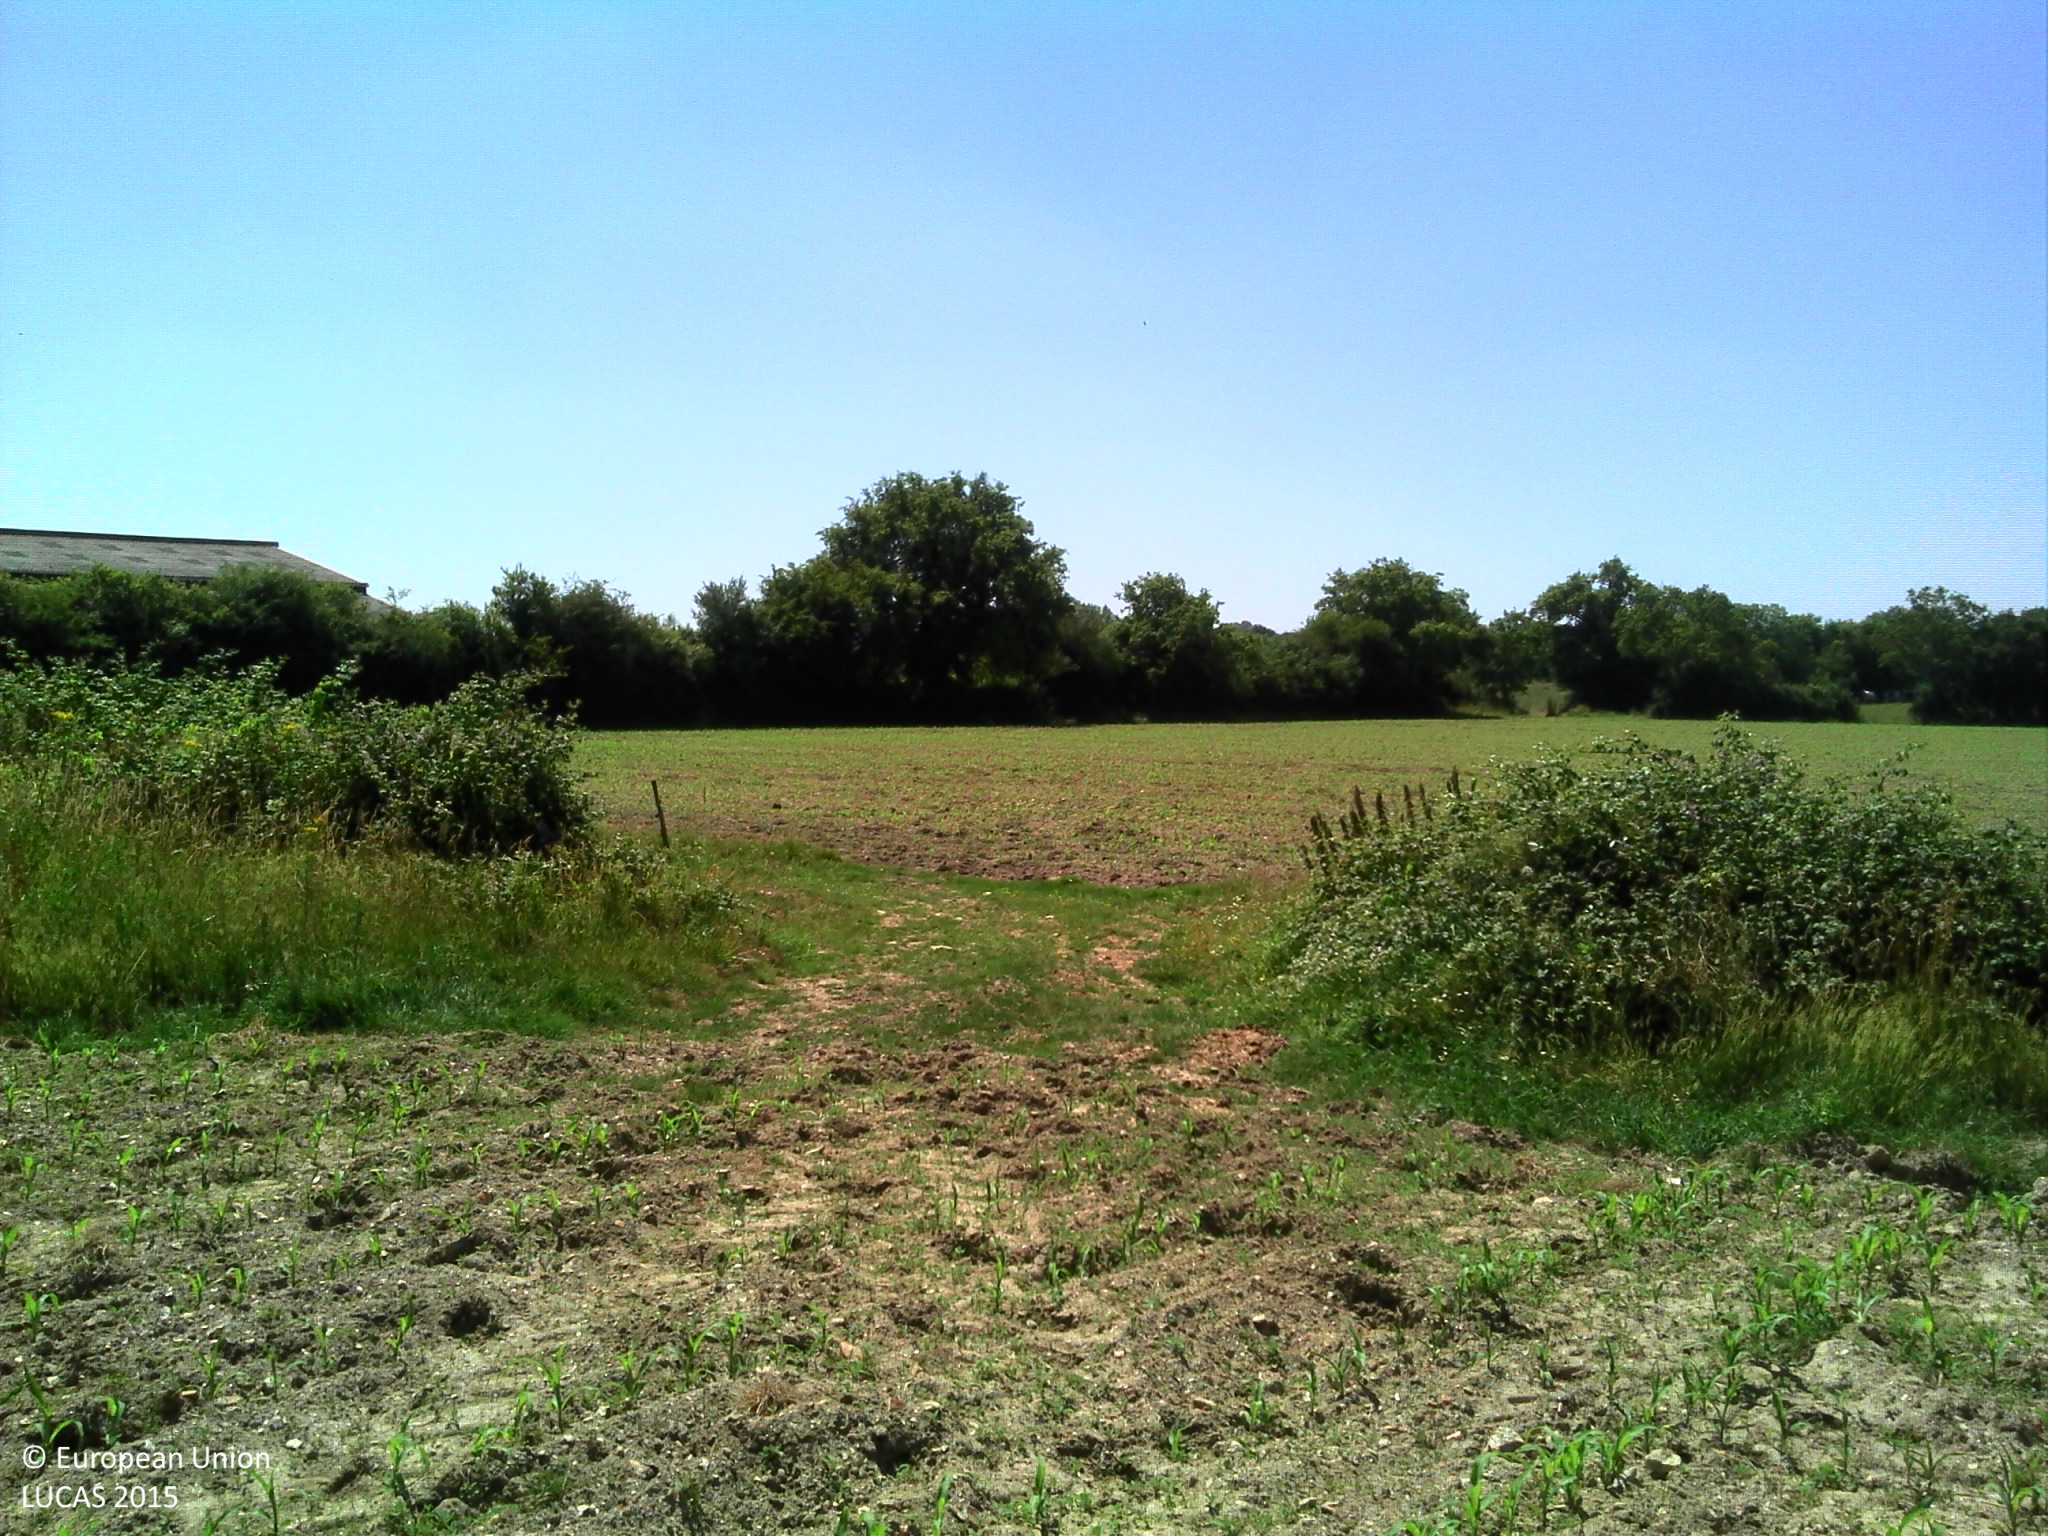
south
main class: Cropland
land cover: Maize
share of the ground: 10 - 25 %
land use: Agriculture (excluding fallow land and kitchen gardens)
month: June
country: FR
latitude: 46.9504
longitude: -1.8035
